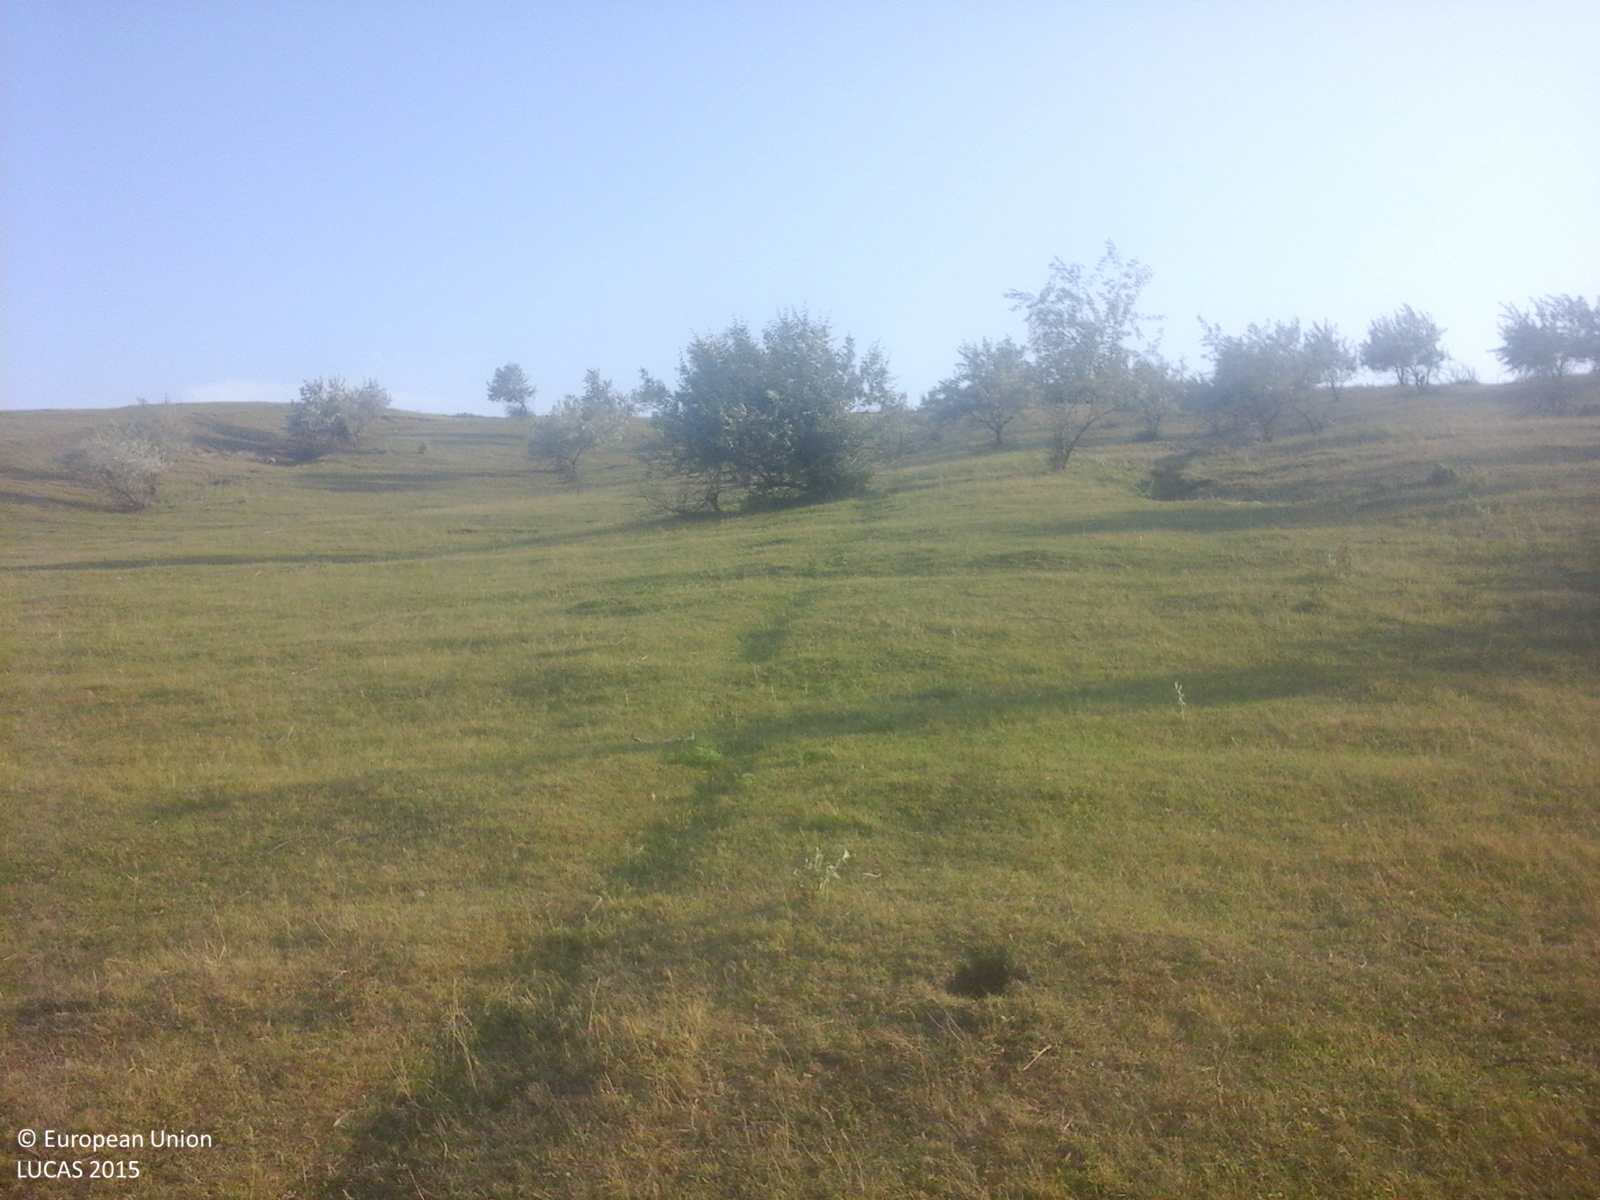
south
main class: Grassland
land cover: Grassland without tree/shrub cover
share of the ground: > 75 %
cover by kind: herbaceous plants 100 %
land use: Agriculture (excluding fallow land and kitchen gardens)
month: June
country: RO
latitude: 46.7354
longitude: 27.7211
